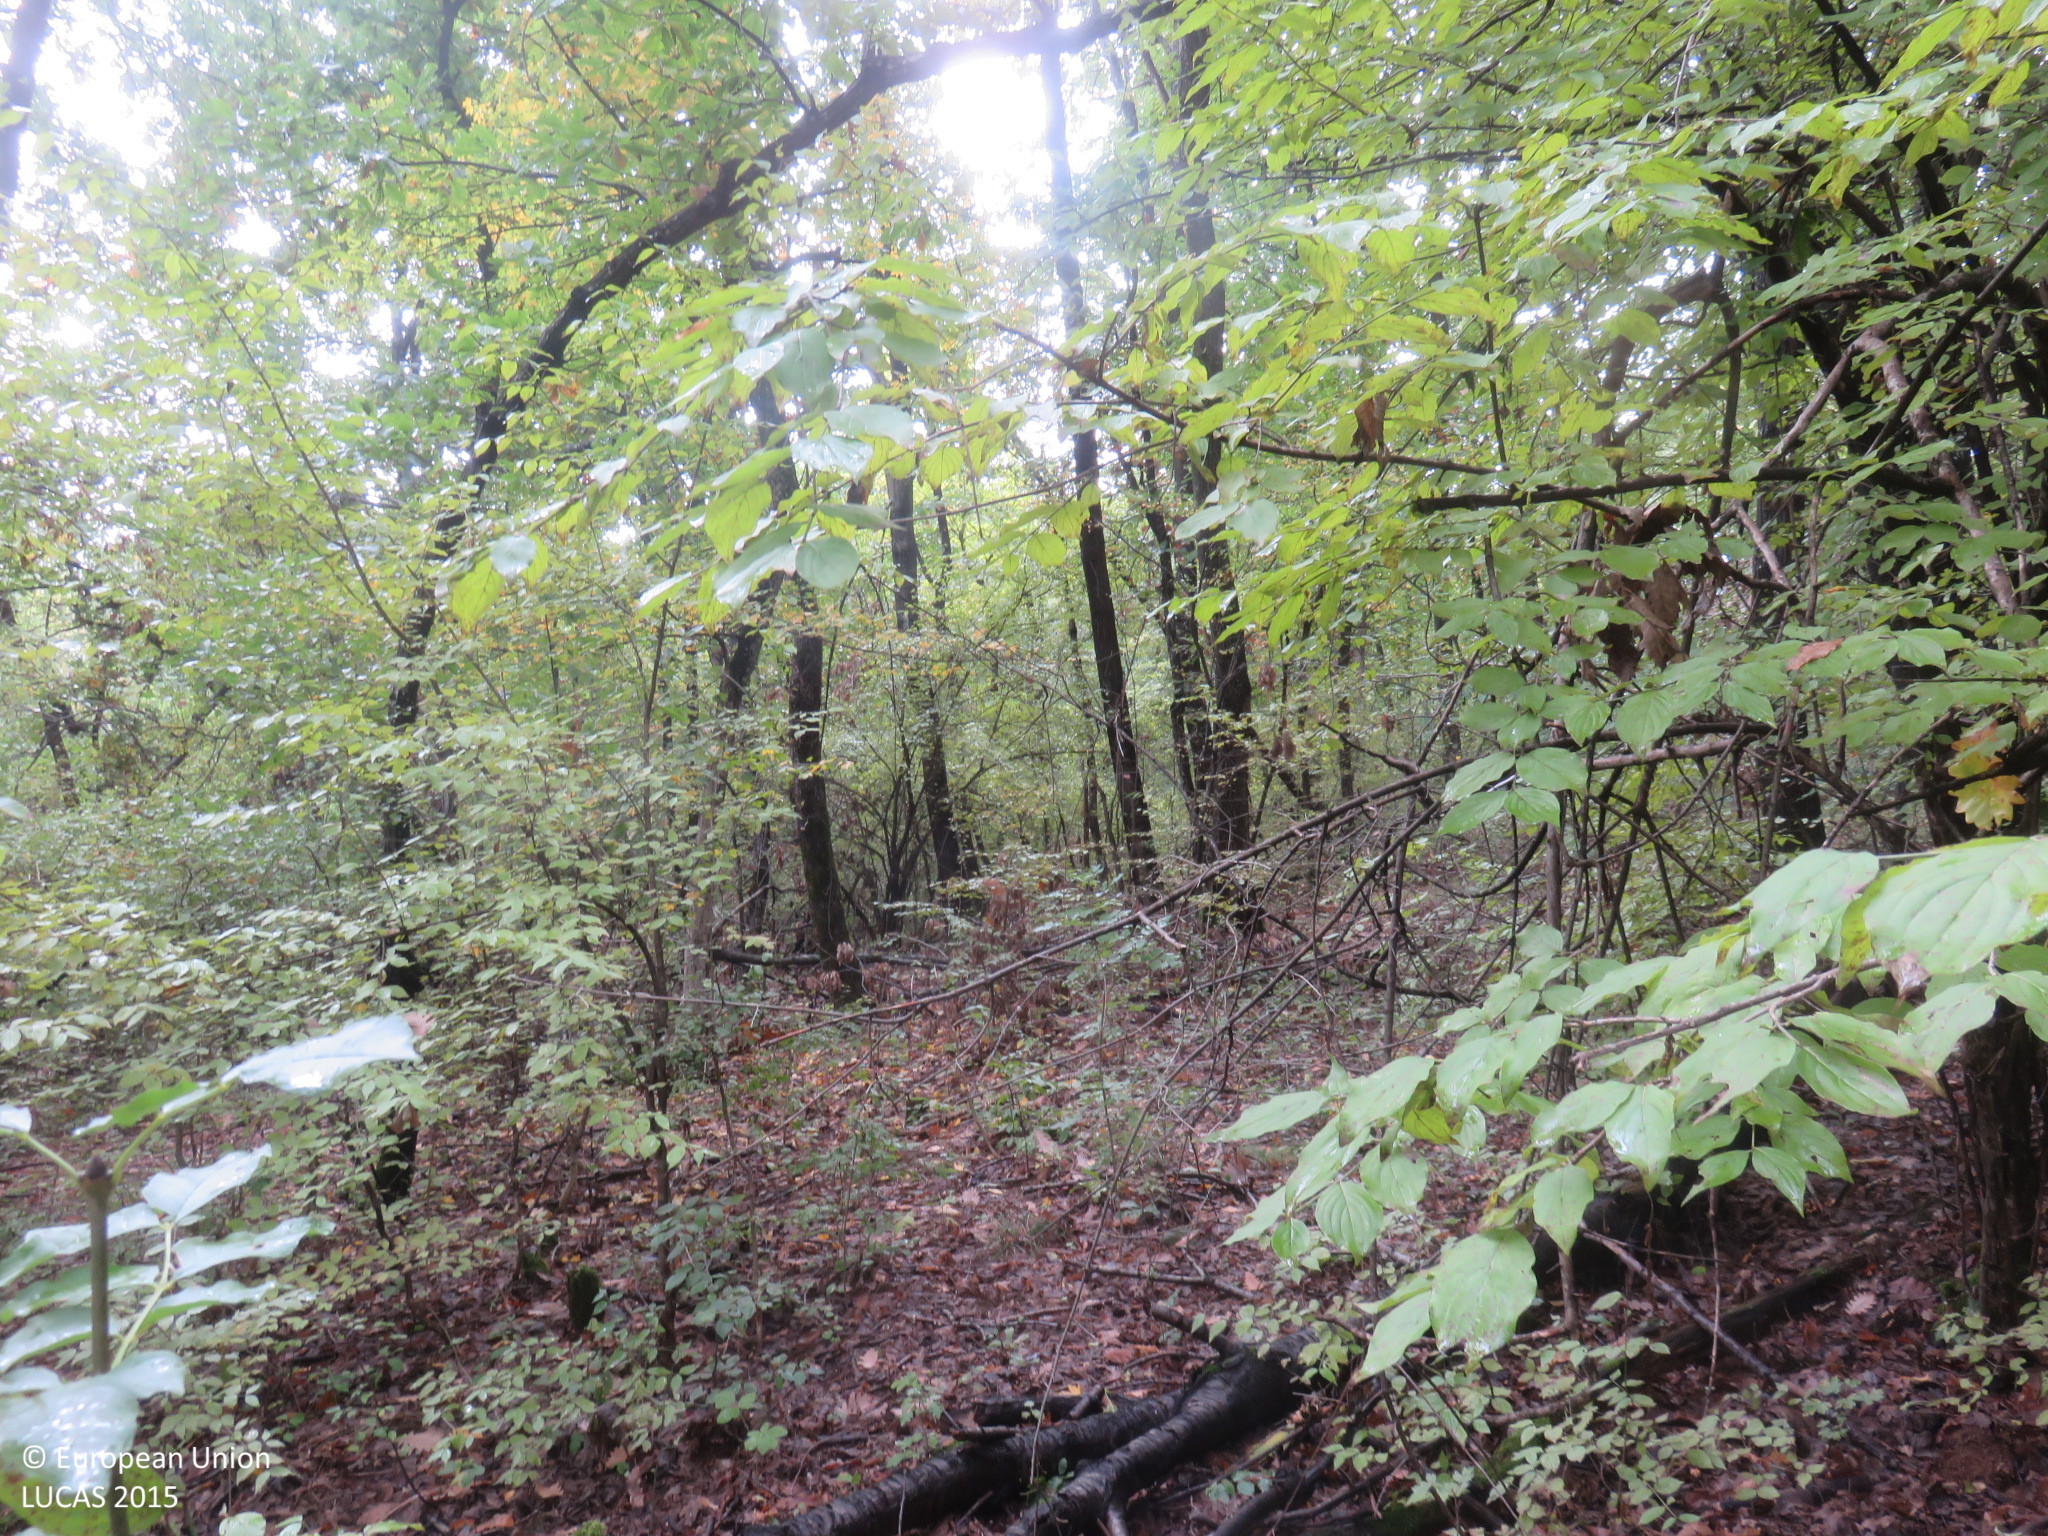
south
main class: Woodland
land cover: Broadleaved woodland
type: mesophytic deciduous forest
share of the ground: > 75 %
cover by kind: broadleaved forest trees 95 %, shrubs 5 %
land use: Forestry
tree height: < 5 m
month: October
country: BG
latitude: 43.0566
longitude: 25.2094
